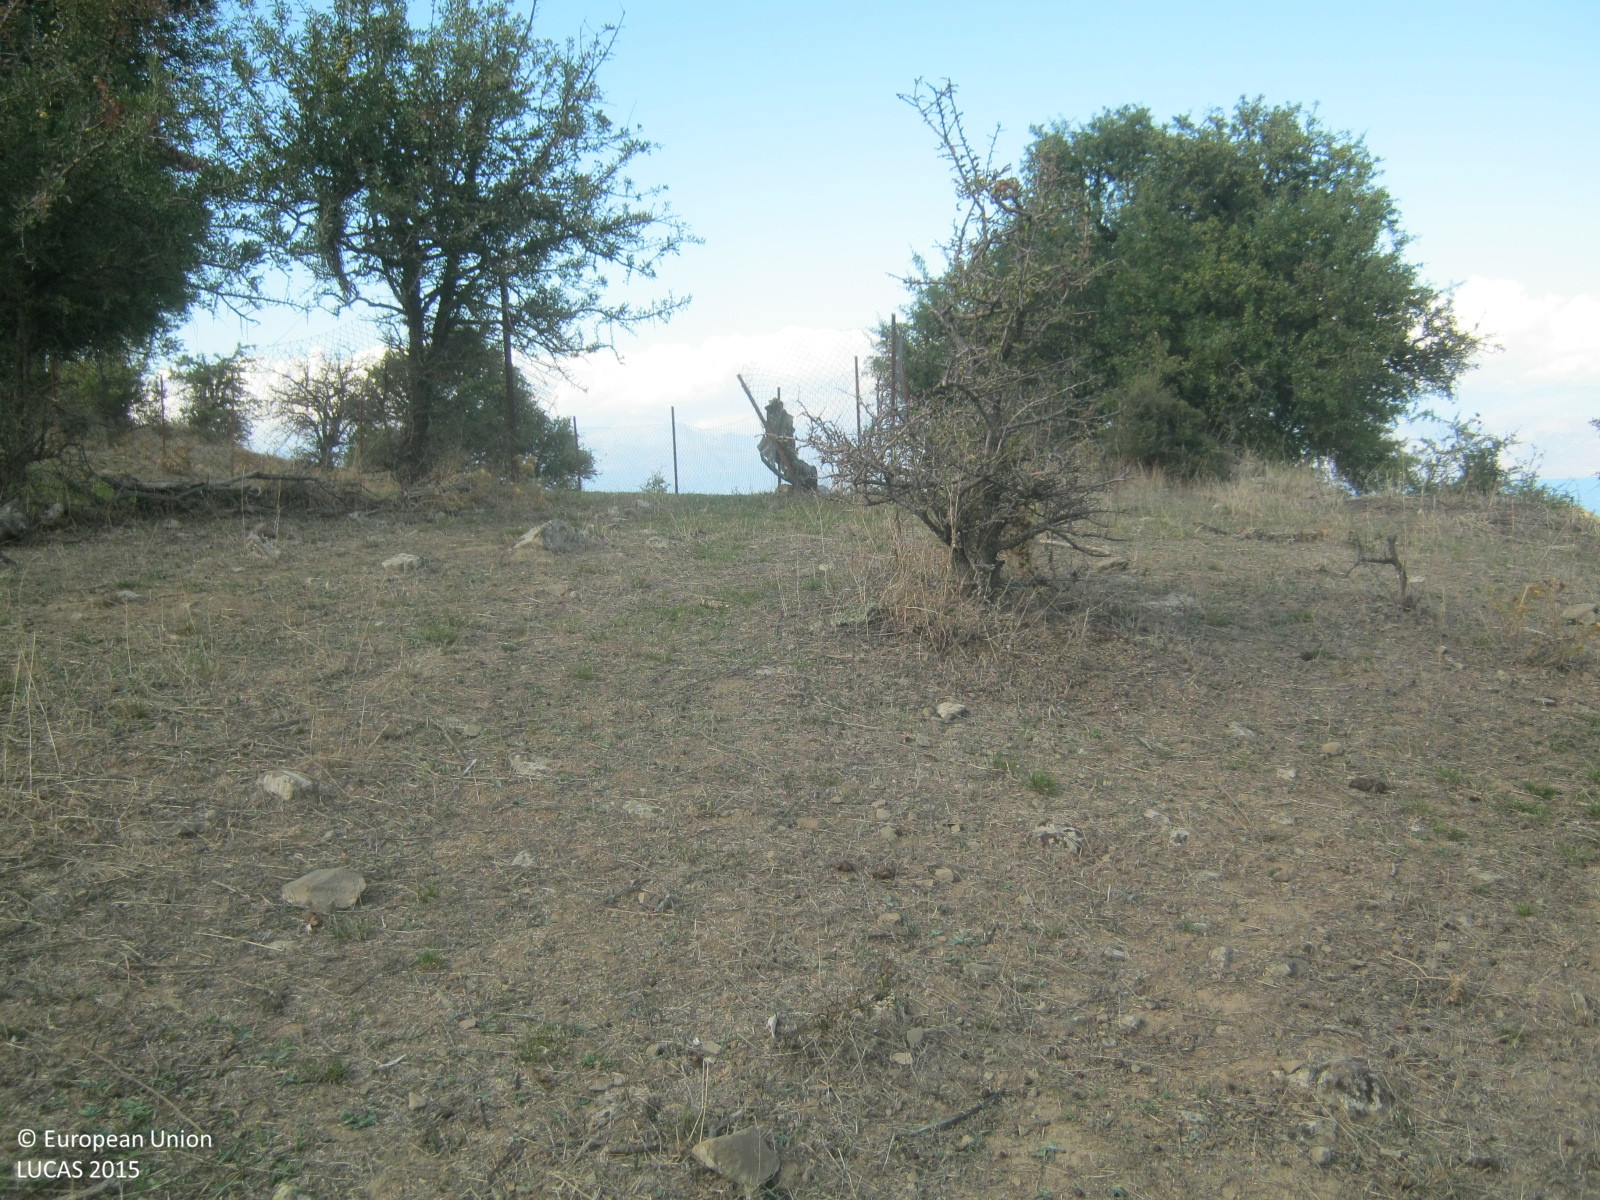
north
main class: Shrubland
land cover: Shrubland with sparse tree cover
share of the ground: 25 - 50 %
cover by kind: herbaceous plants 50 %, shrubs 25 %, unconsolidated bare surface 20 %, broadleaved forest trees 5 %
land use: Agriculture (excluding fallow land and kitchen gardens)
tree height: < 5 m
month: September
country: GR
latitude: 38.1383
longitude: 22.1426
